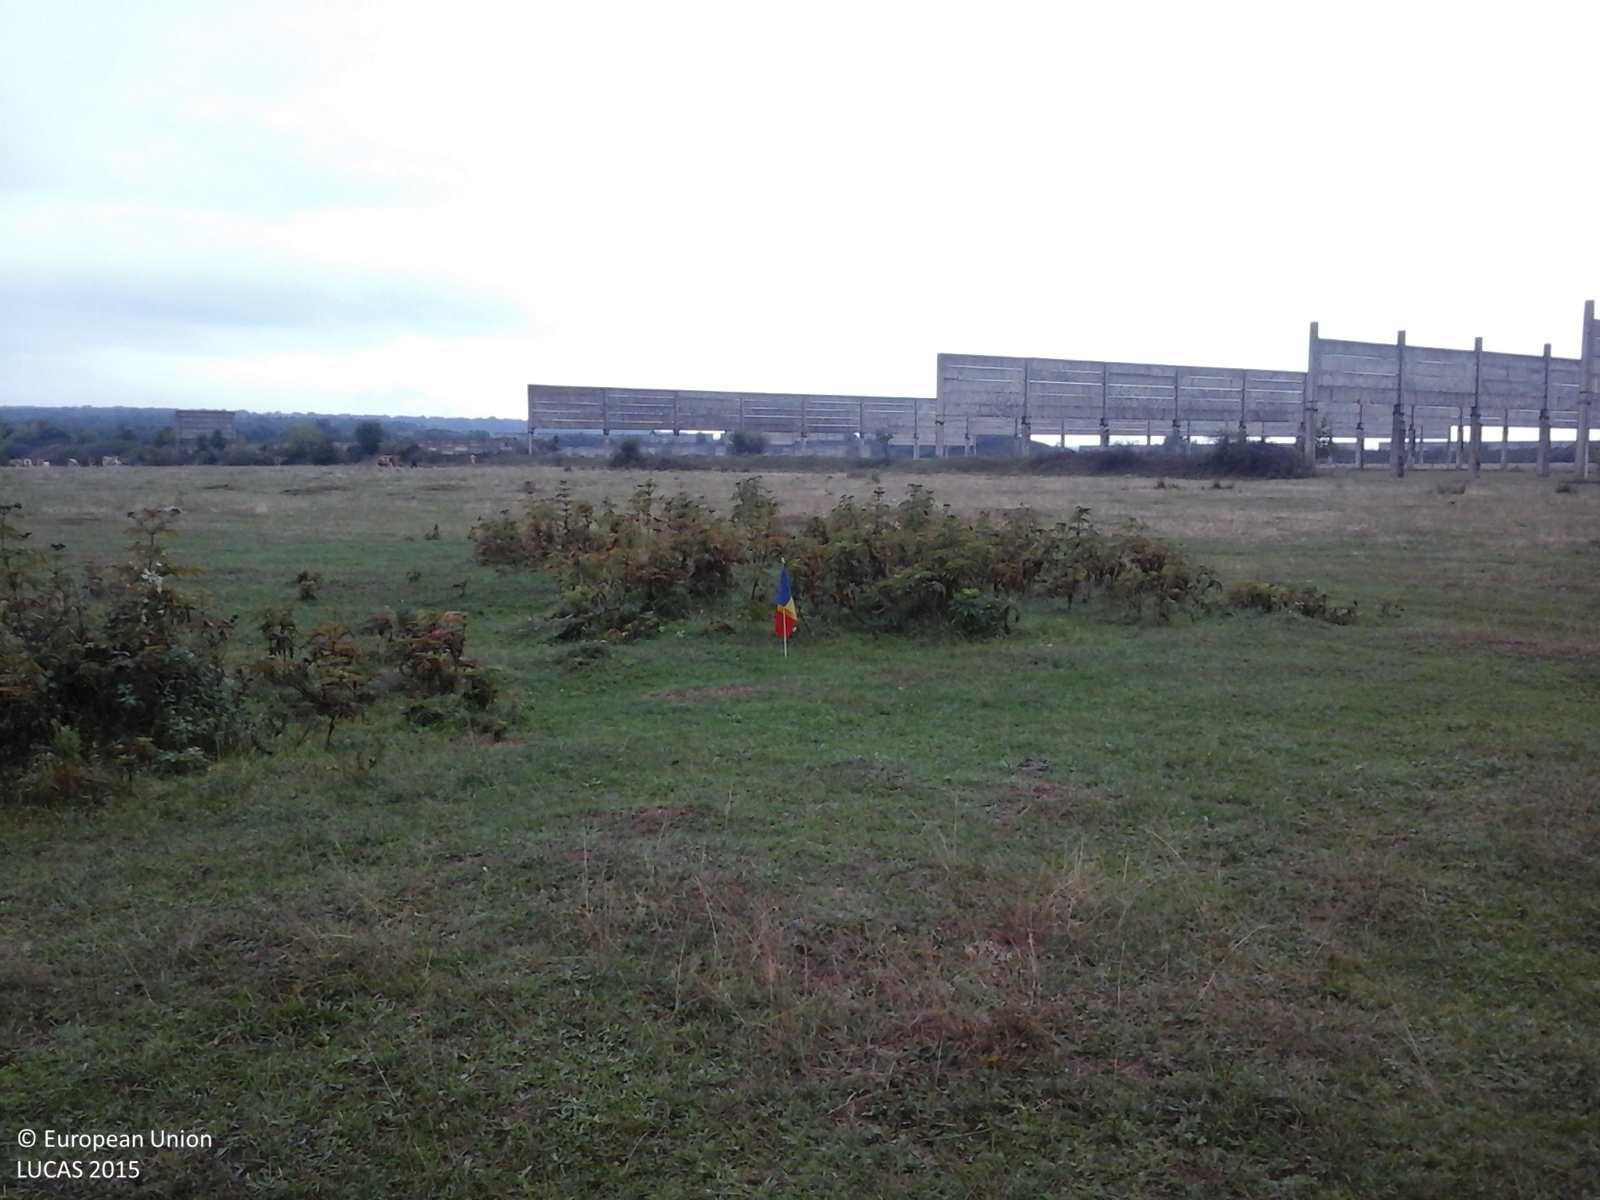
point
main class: Grassland
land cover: Grassland without tree/shrub cover
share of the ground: > 75 %
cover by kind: herbaceous plants 100 %
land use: Agriculture (excluding fallow land and kitchen gardens)
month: September
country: RO
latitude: 46.9892
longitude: 21.9456
